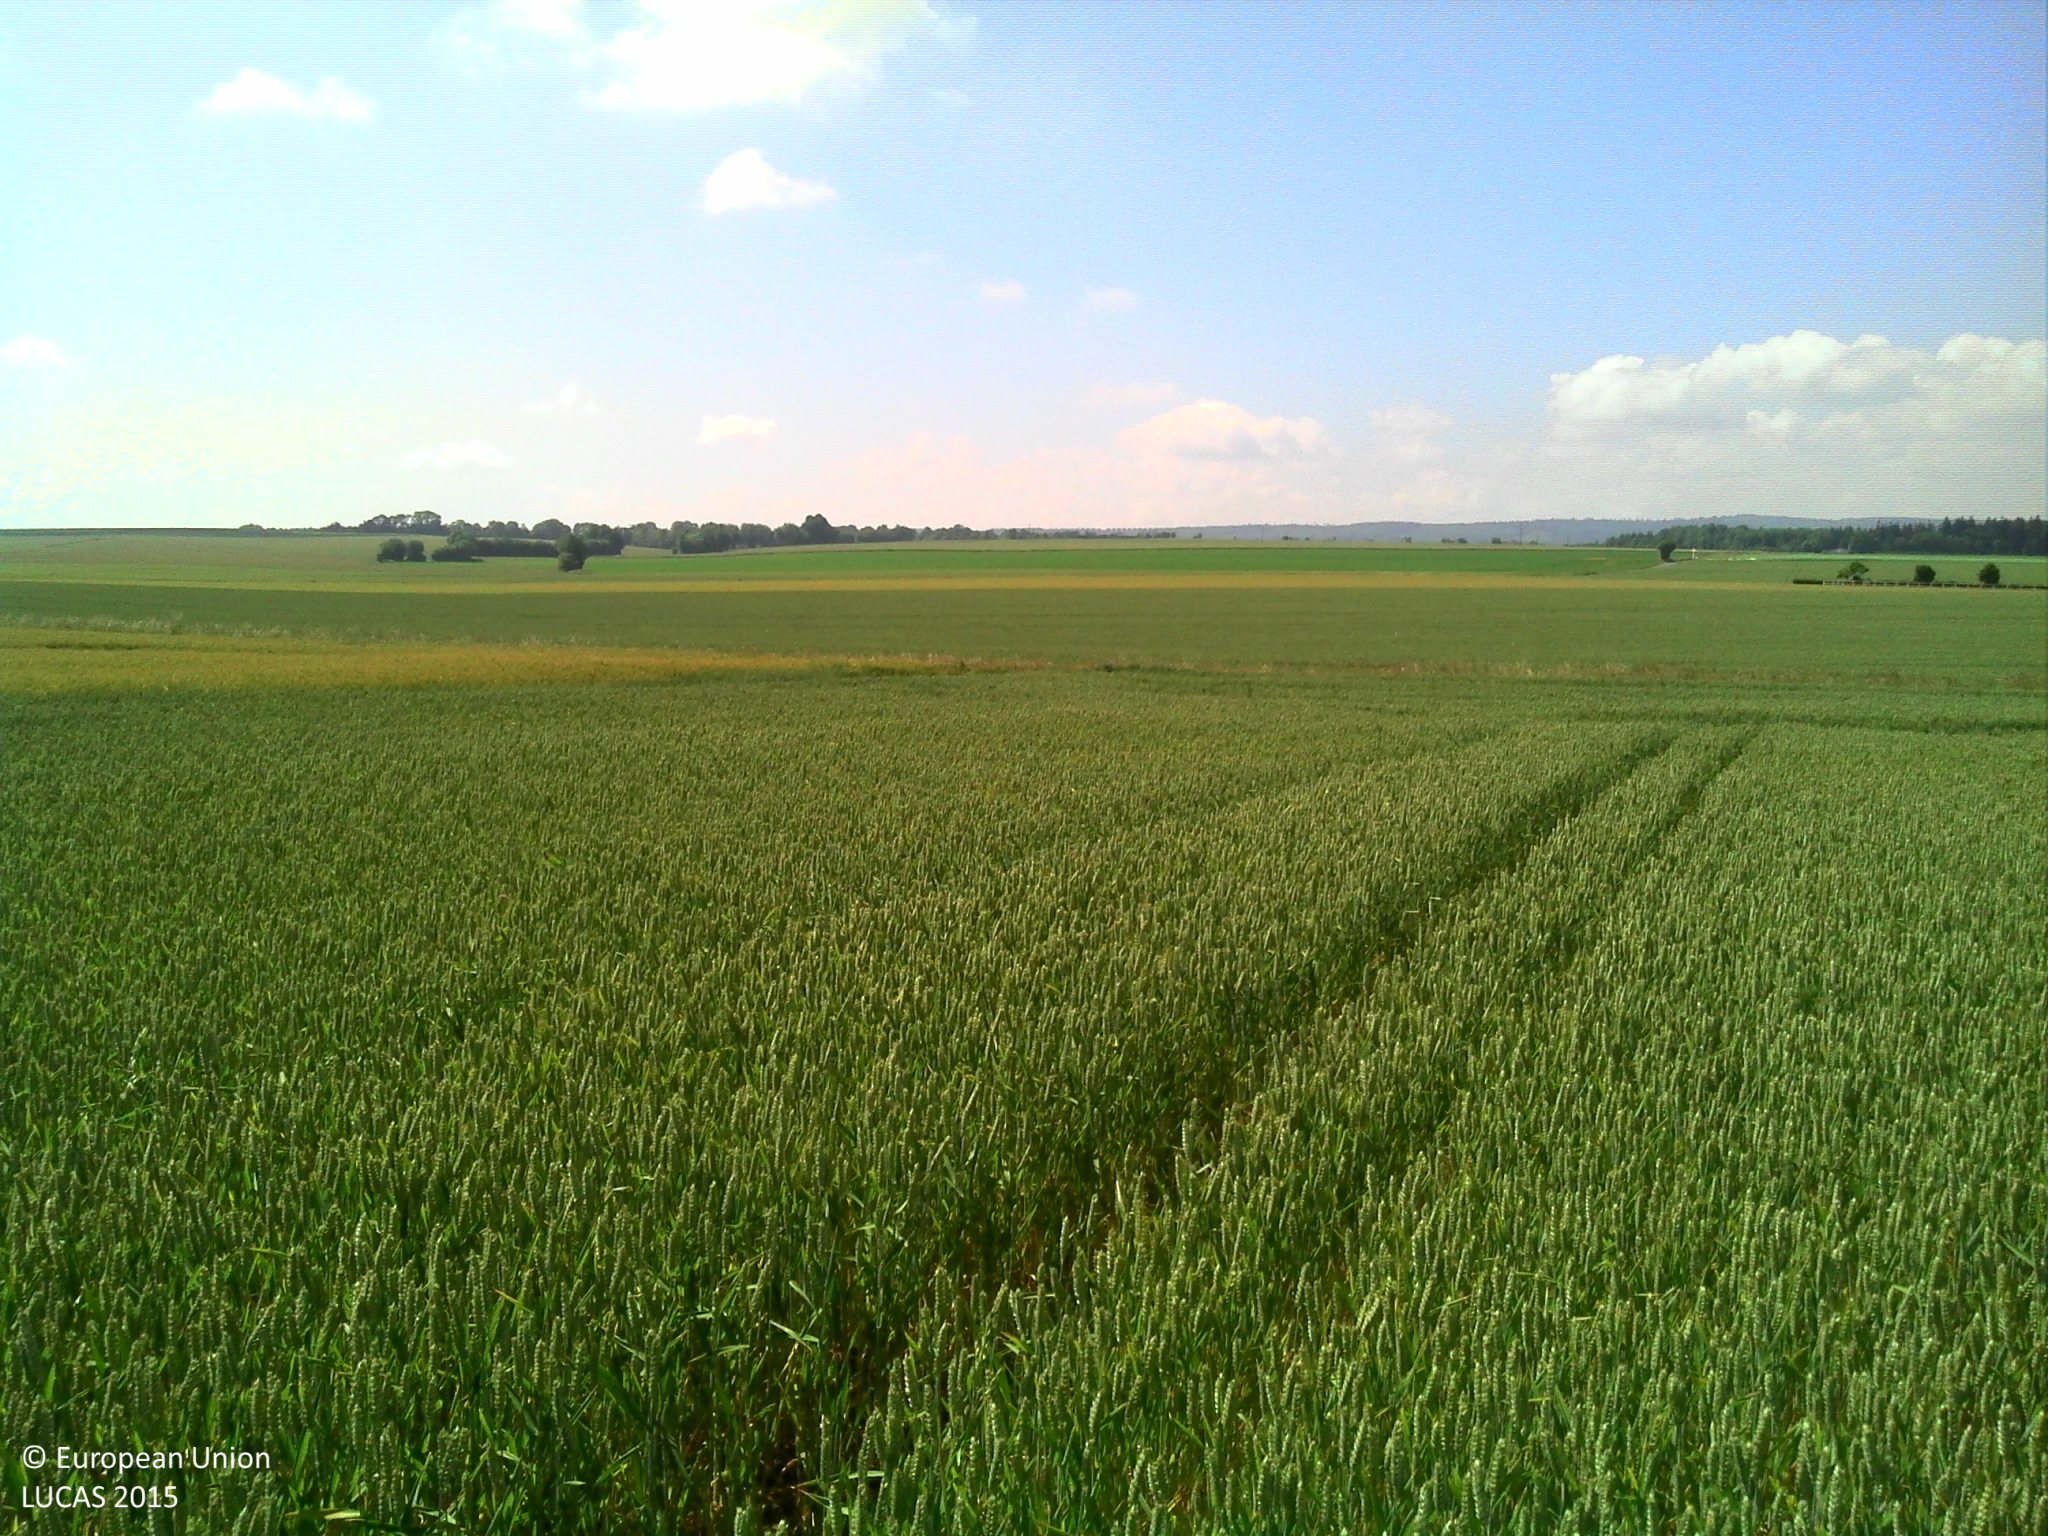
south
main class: Cropland
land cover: Common wheat
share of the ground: > 75 %
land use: Agriculture (excluding fallow land and kitchen gardens)
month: June
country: FR
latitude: 48.6294
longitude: 0.1070
